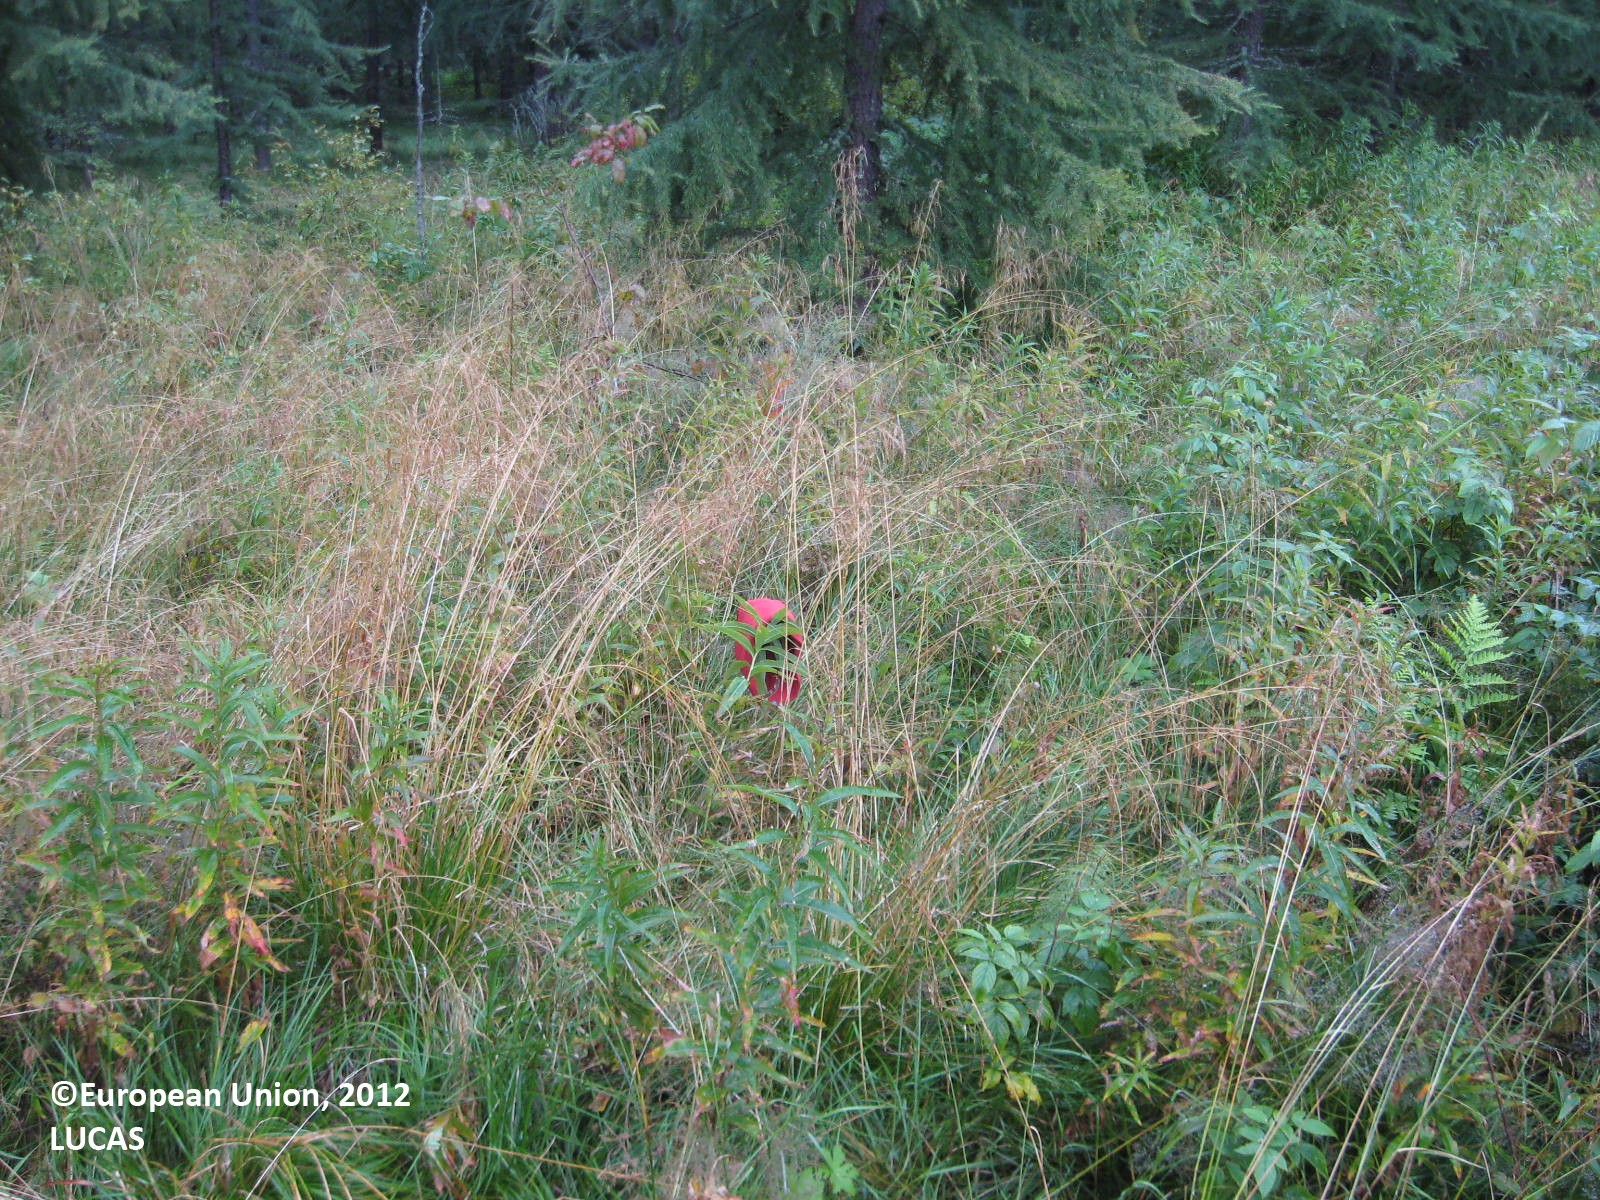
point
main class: Grassland
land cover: Spontaneously vegetated surfaces
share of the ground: > 75 %
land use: Residential
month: August
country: FI
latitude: 63.5716
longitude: 29.7084
